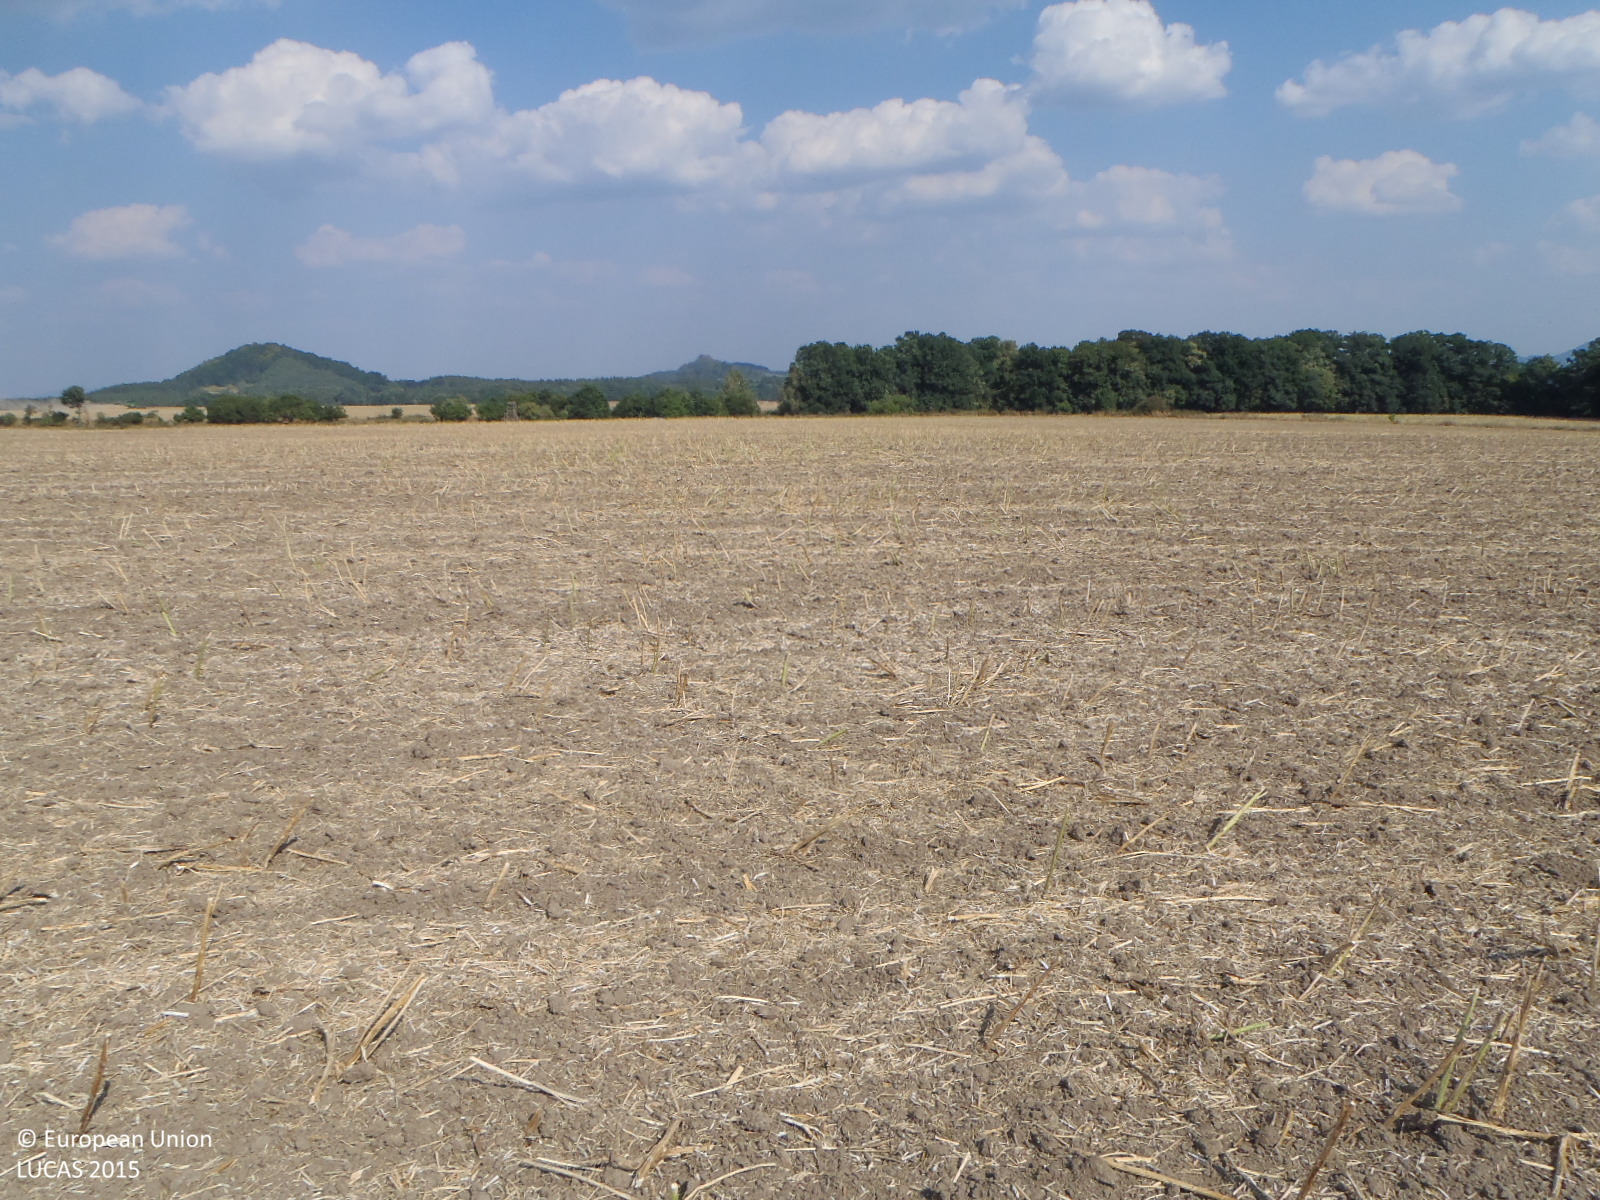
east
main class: Cropland
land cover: Rape and turnip rape
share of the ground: 50 - 75 %
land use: Agriculture (excluding fallow land and kitchen gardens)
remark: Harvested field
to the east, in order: Rape and turnip rape
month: August
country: CZ
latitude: 50.6341
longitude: 14.5404
